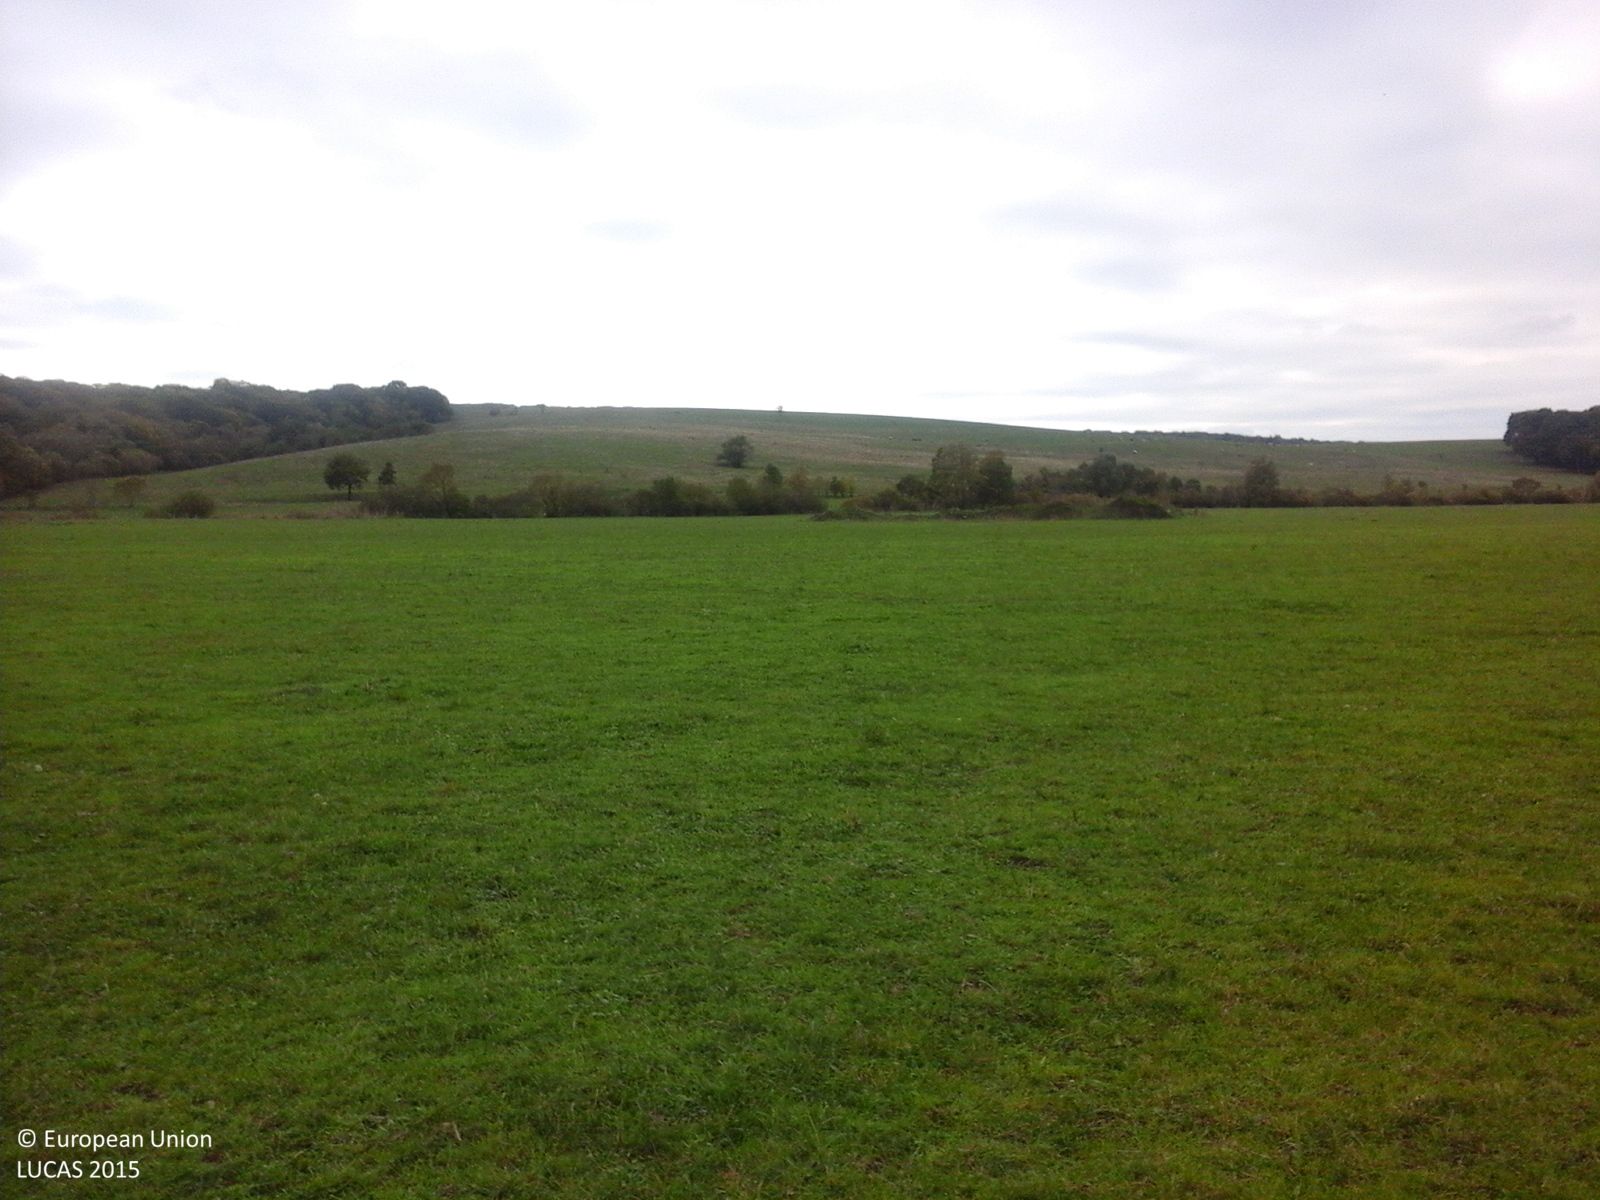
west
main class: Grassland
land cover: Grassland without tree/shrub cover
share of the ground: > 75 %
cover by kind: herbaceous plants 100 %
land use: Agriculture (excluding fallow land and kitchen gardens)
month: October
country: RO
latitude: 45.8937
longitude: 24.8461
